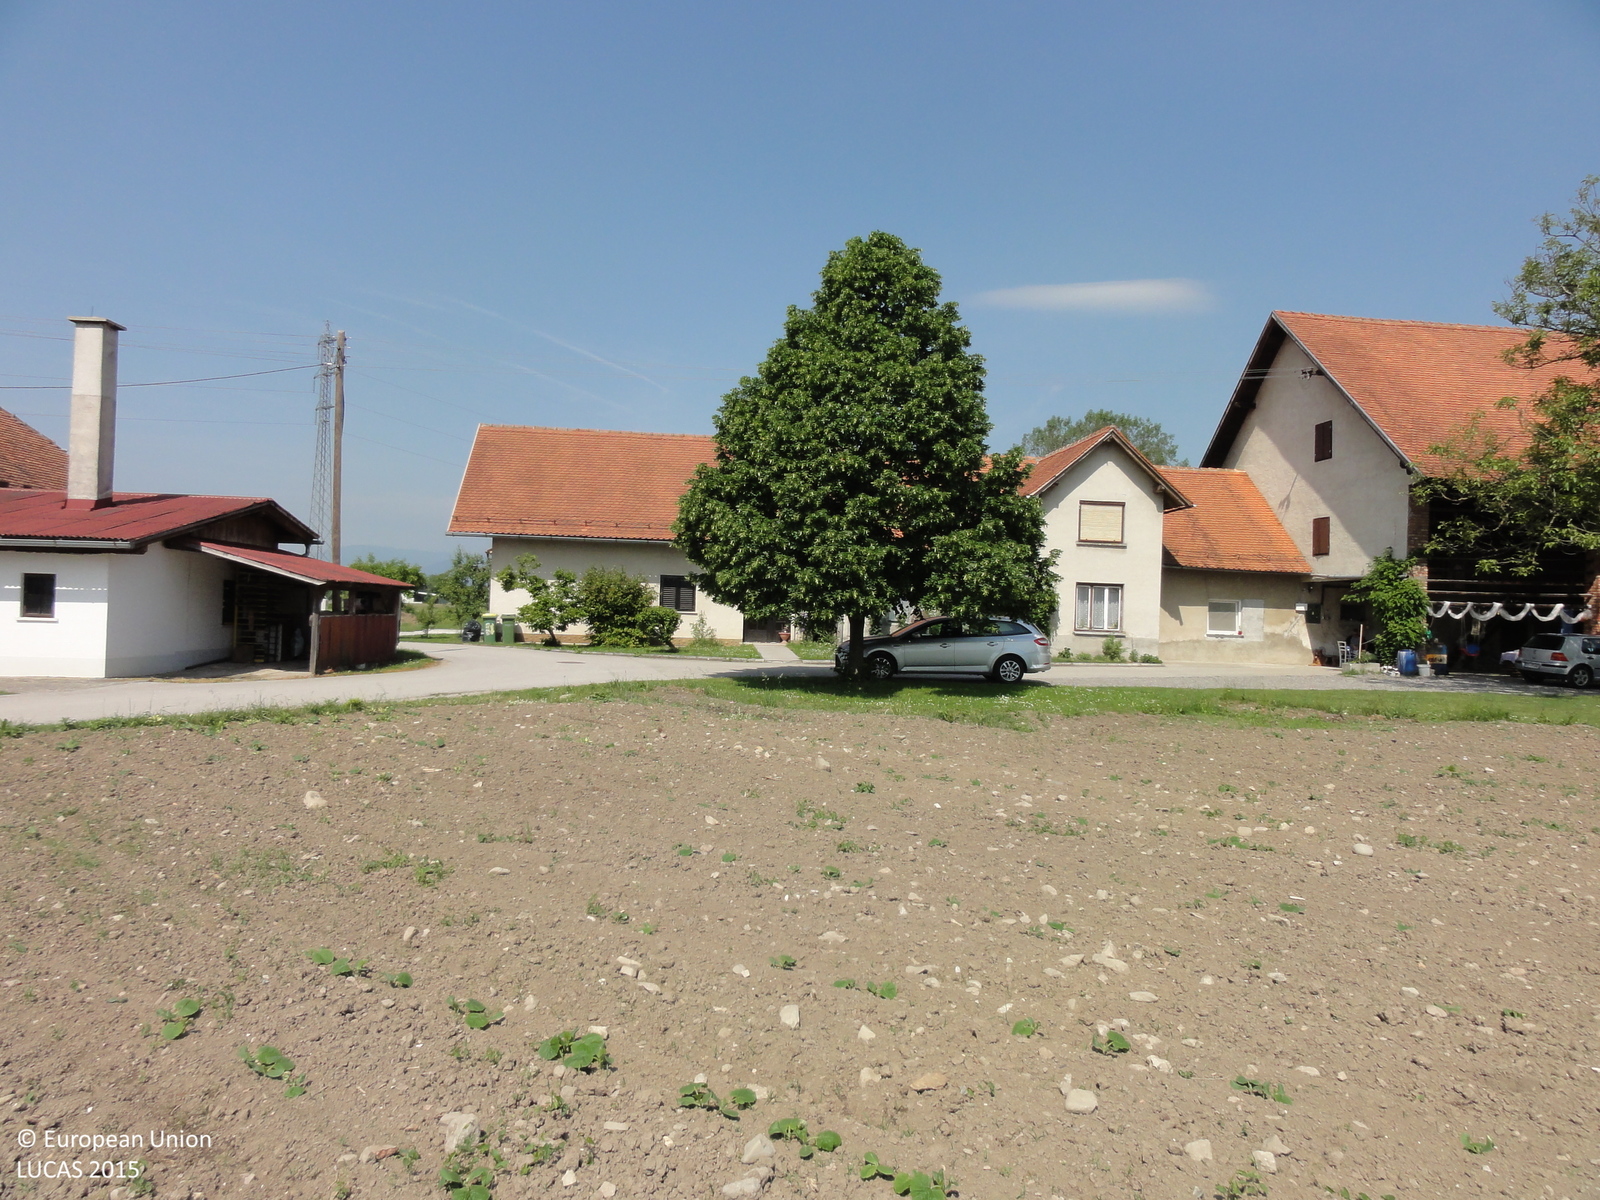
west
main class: Cropland
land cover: Other fresh vegetables
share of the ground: < 10 %
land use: Agriculture (excluding fallow land and kitchen gardens)
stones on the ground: 10 - 25 %
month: May
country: SI
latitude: 46.2634
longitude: 15.1483
